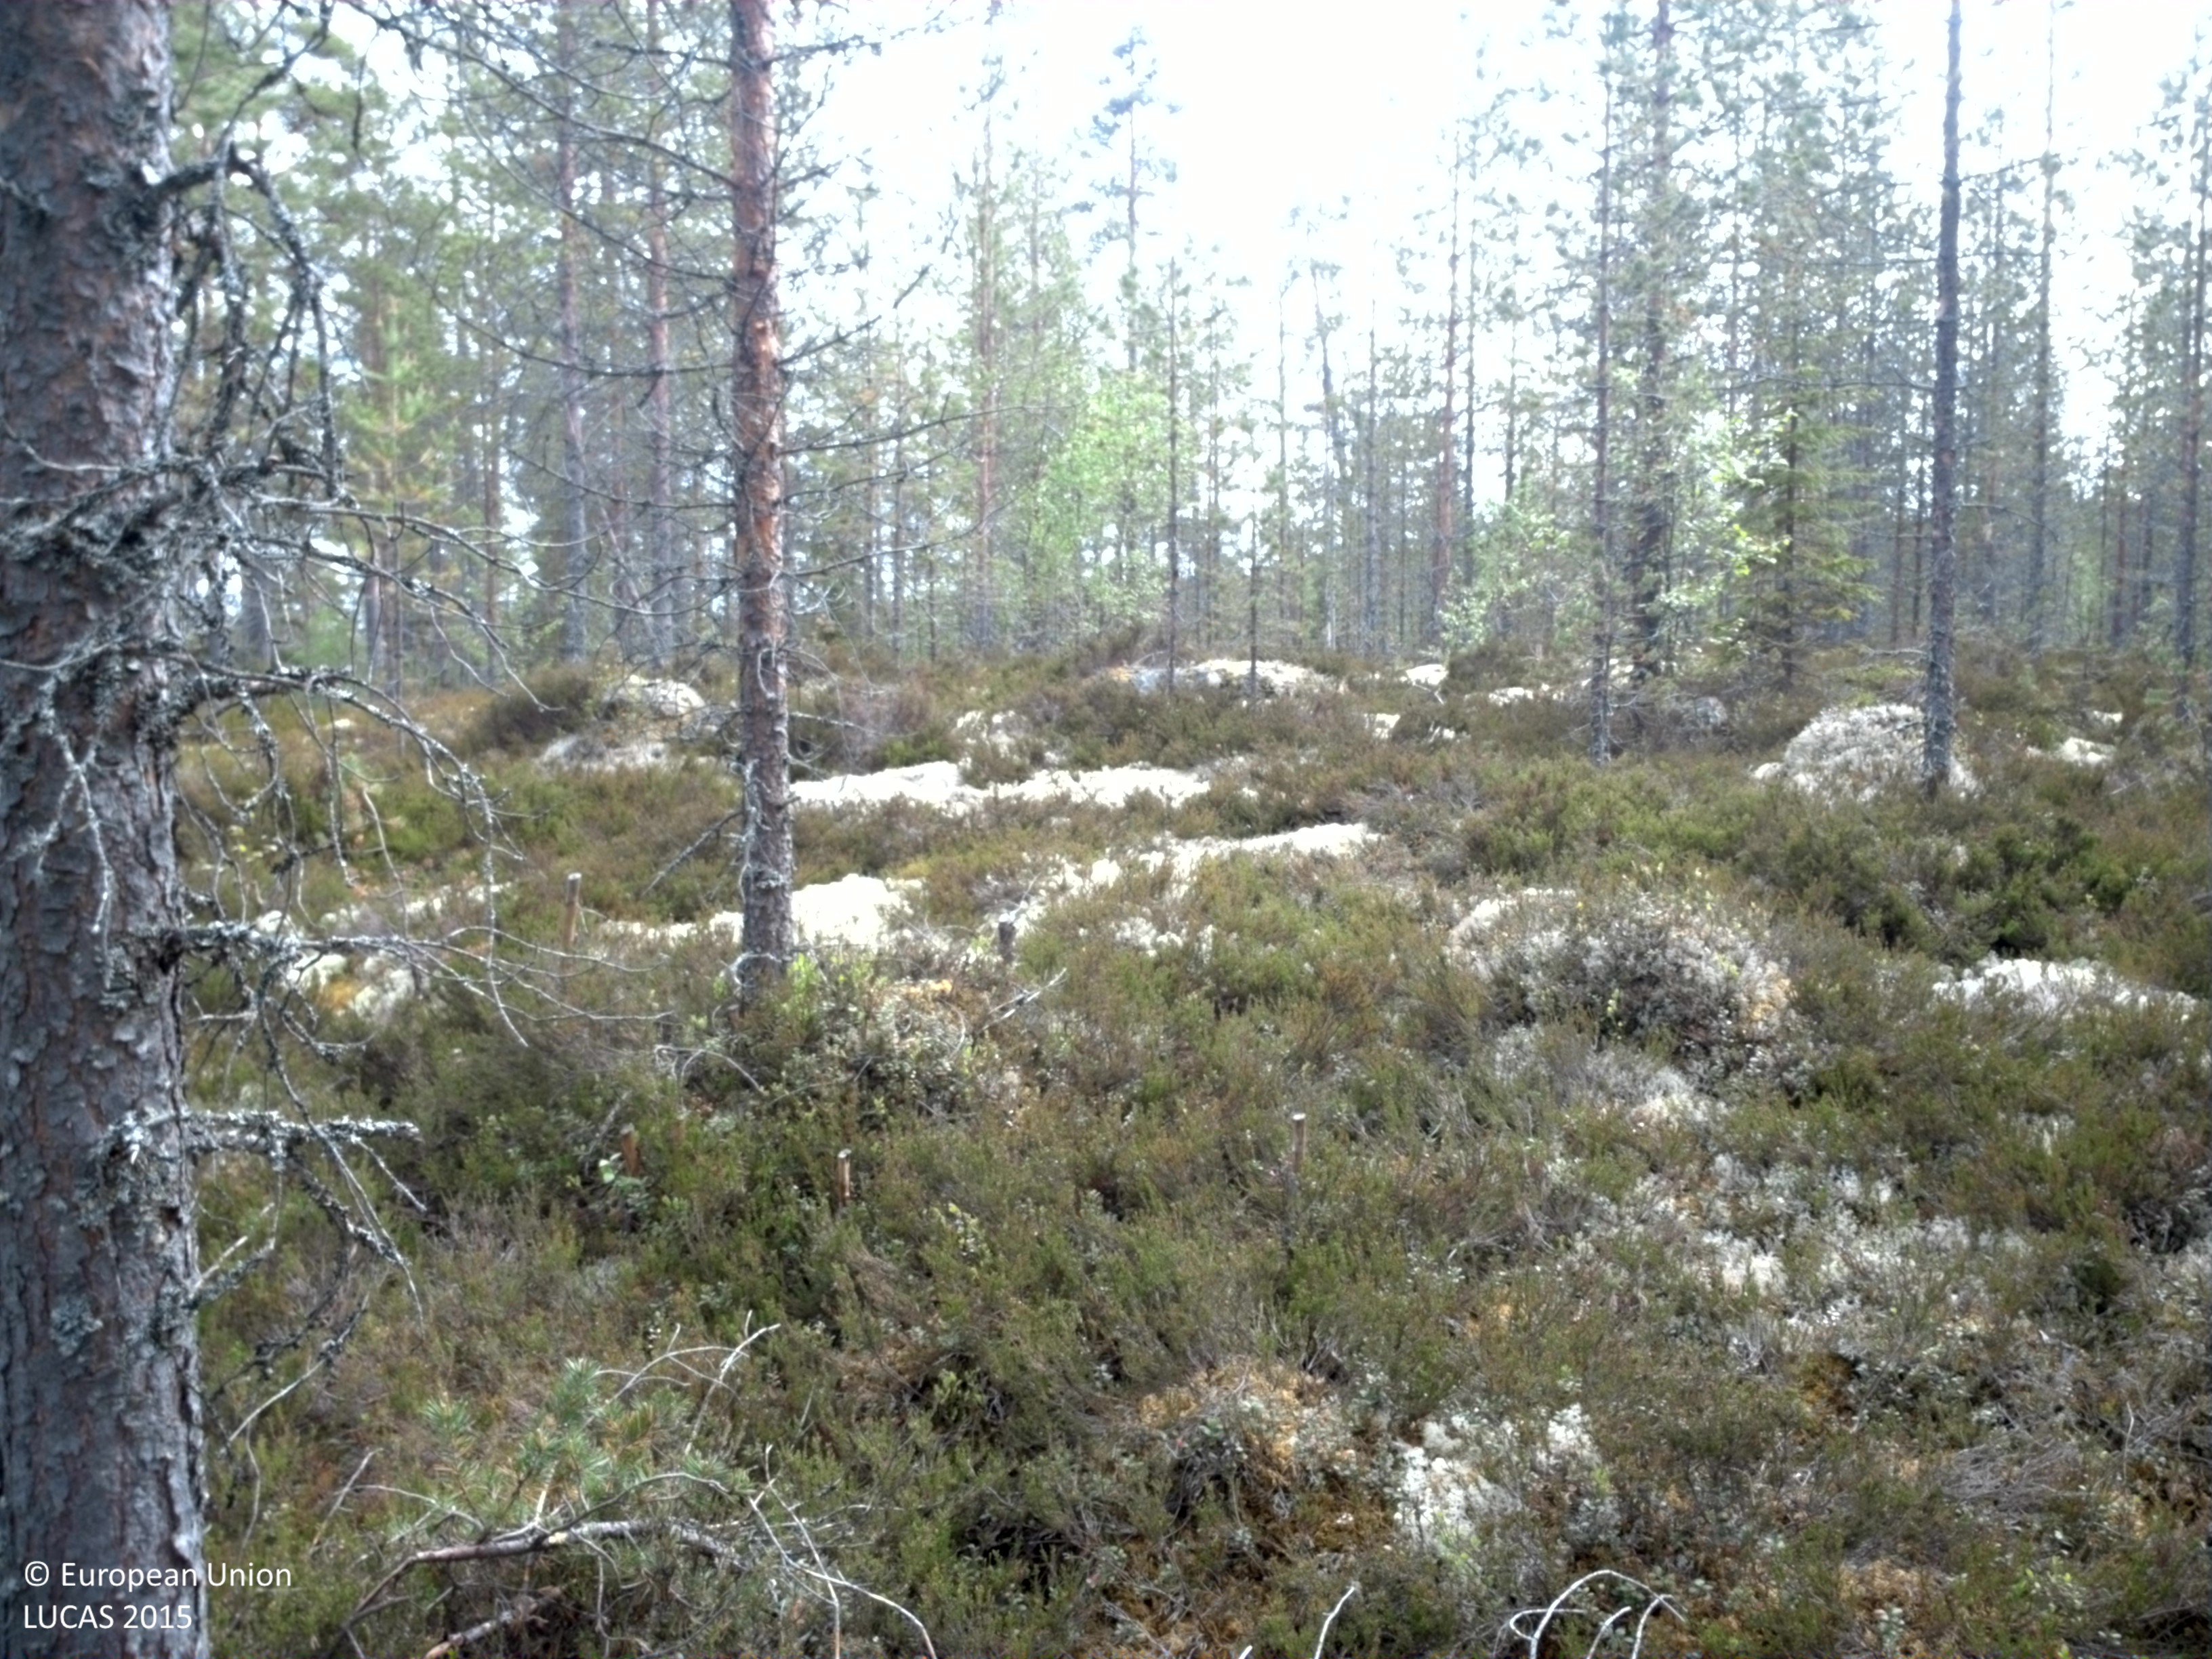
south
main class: Woodland
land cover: Pine dominated coniferous woodland
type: boreal forest
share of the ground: 25 - 50 %
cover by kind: coniferous forest trees 40 %, lichens and mosses 35 %, herbaceous plants 25 %
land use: Forestry
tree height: > 5 m
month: June
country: SE
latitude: 61.3795
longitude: 13.5619
